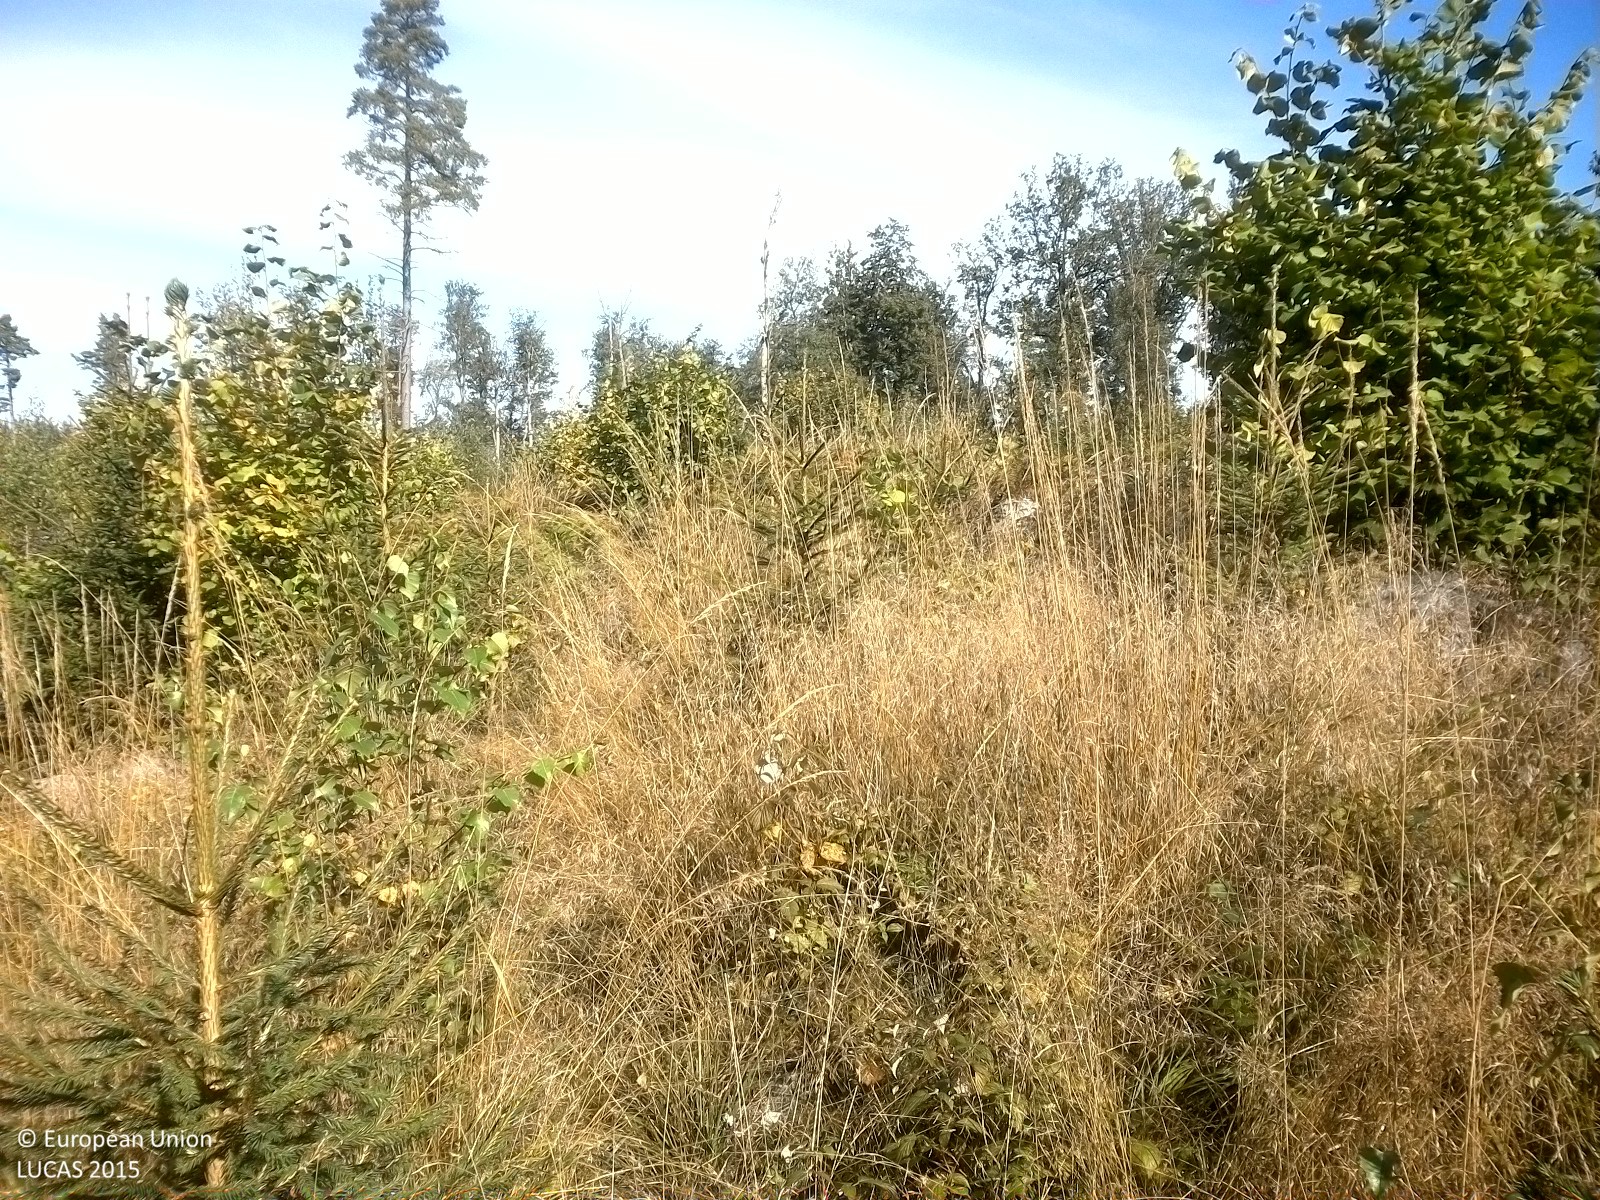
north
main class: Woodland
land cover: Spruce dominated mixed woodland
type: boreal forest
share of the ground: 25 - 50 %
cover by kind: herbaceous plants 40 %, coniferous forest trees 20 %, broadleaved forest trees 20 %, shrubs 10 %, lichens and mosses 10 %
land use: Forestry
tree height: < 5 m
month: September
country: SE
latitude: 59.0371
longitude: 15.6912
